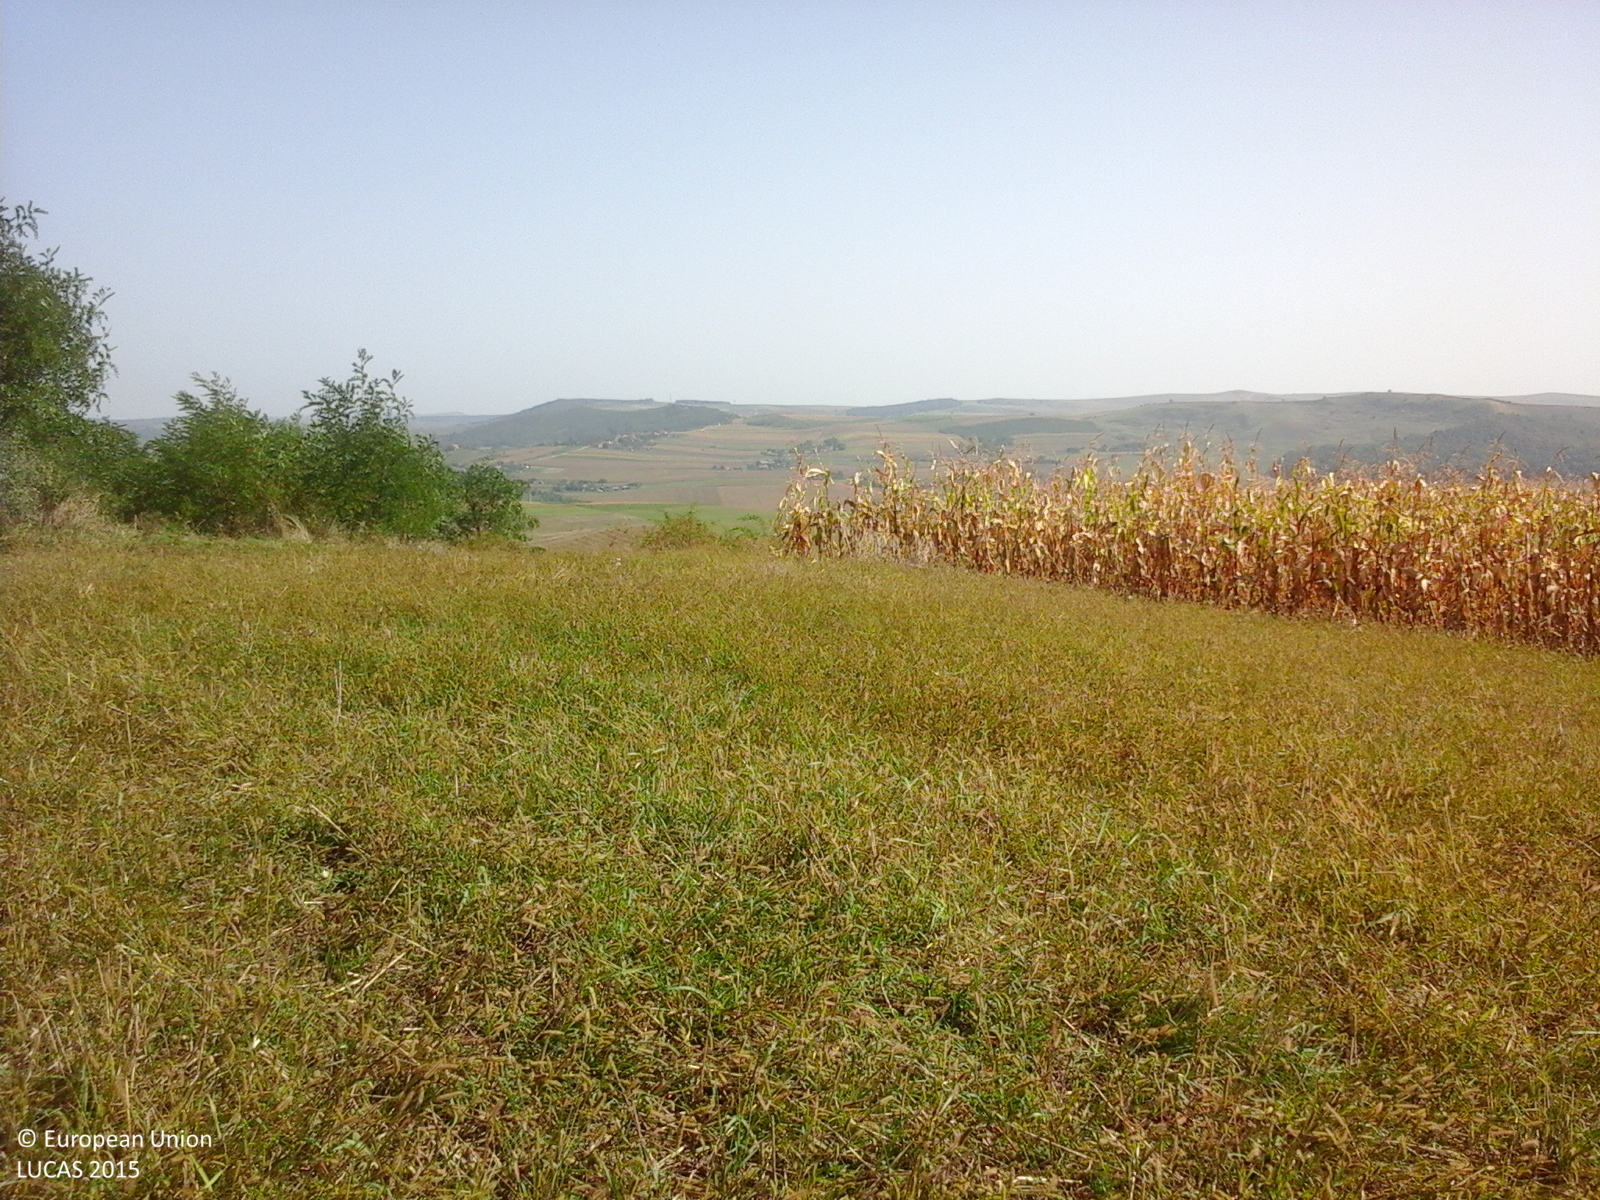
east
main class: Grassland
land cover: Grassland without tree/shrub cover
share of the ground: > 75 %
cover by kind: herbaceous plants 100 %
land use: Agriculture (excluding fallow land and kitchen gardens)
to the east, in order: Grassland without tree/shrub cover; Maize; Grass margins; Tracks; Spontaneously vegetated surfaces; Lucerne; Spontaneously vegetated surfaces; Lucerne; Sunflower
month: September
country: RO
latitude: 46.7420
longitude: 24.1247
